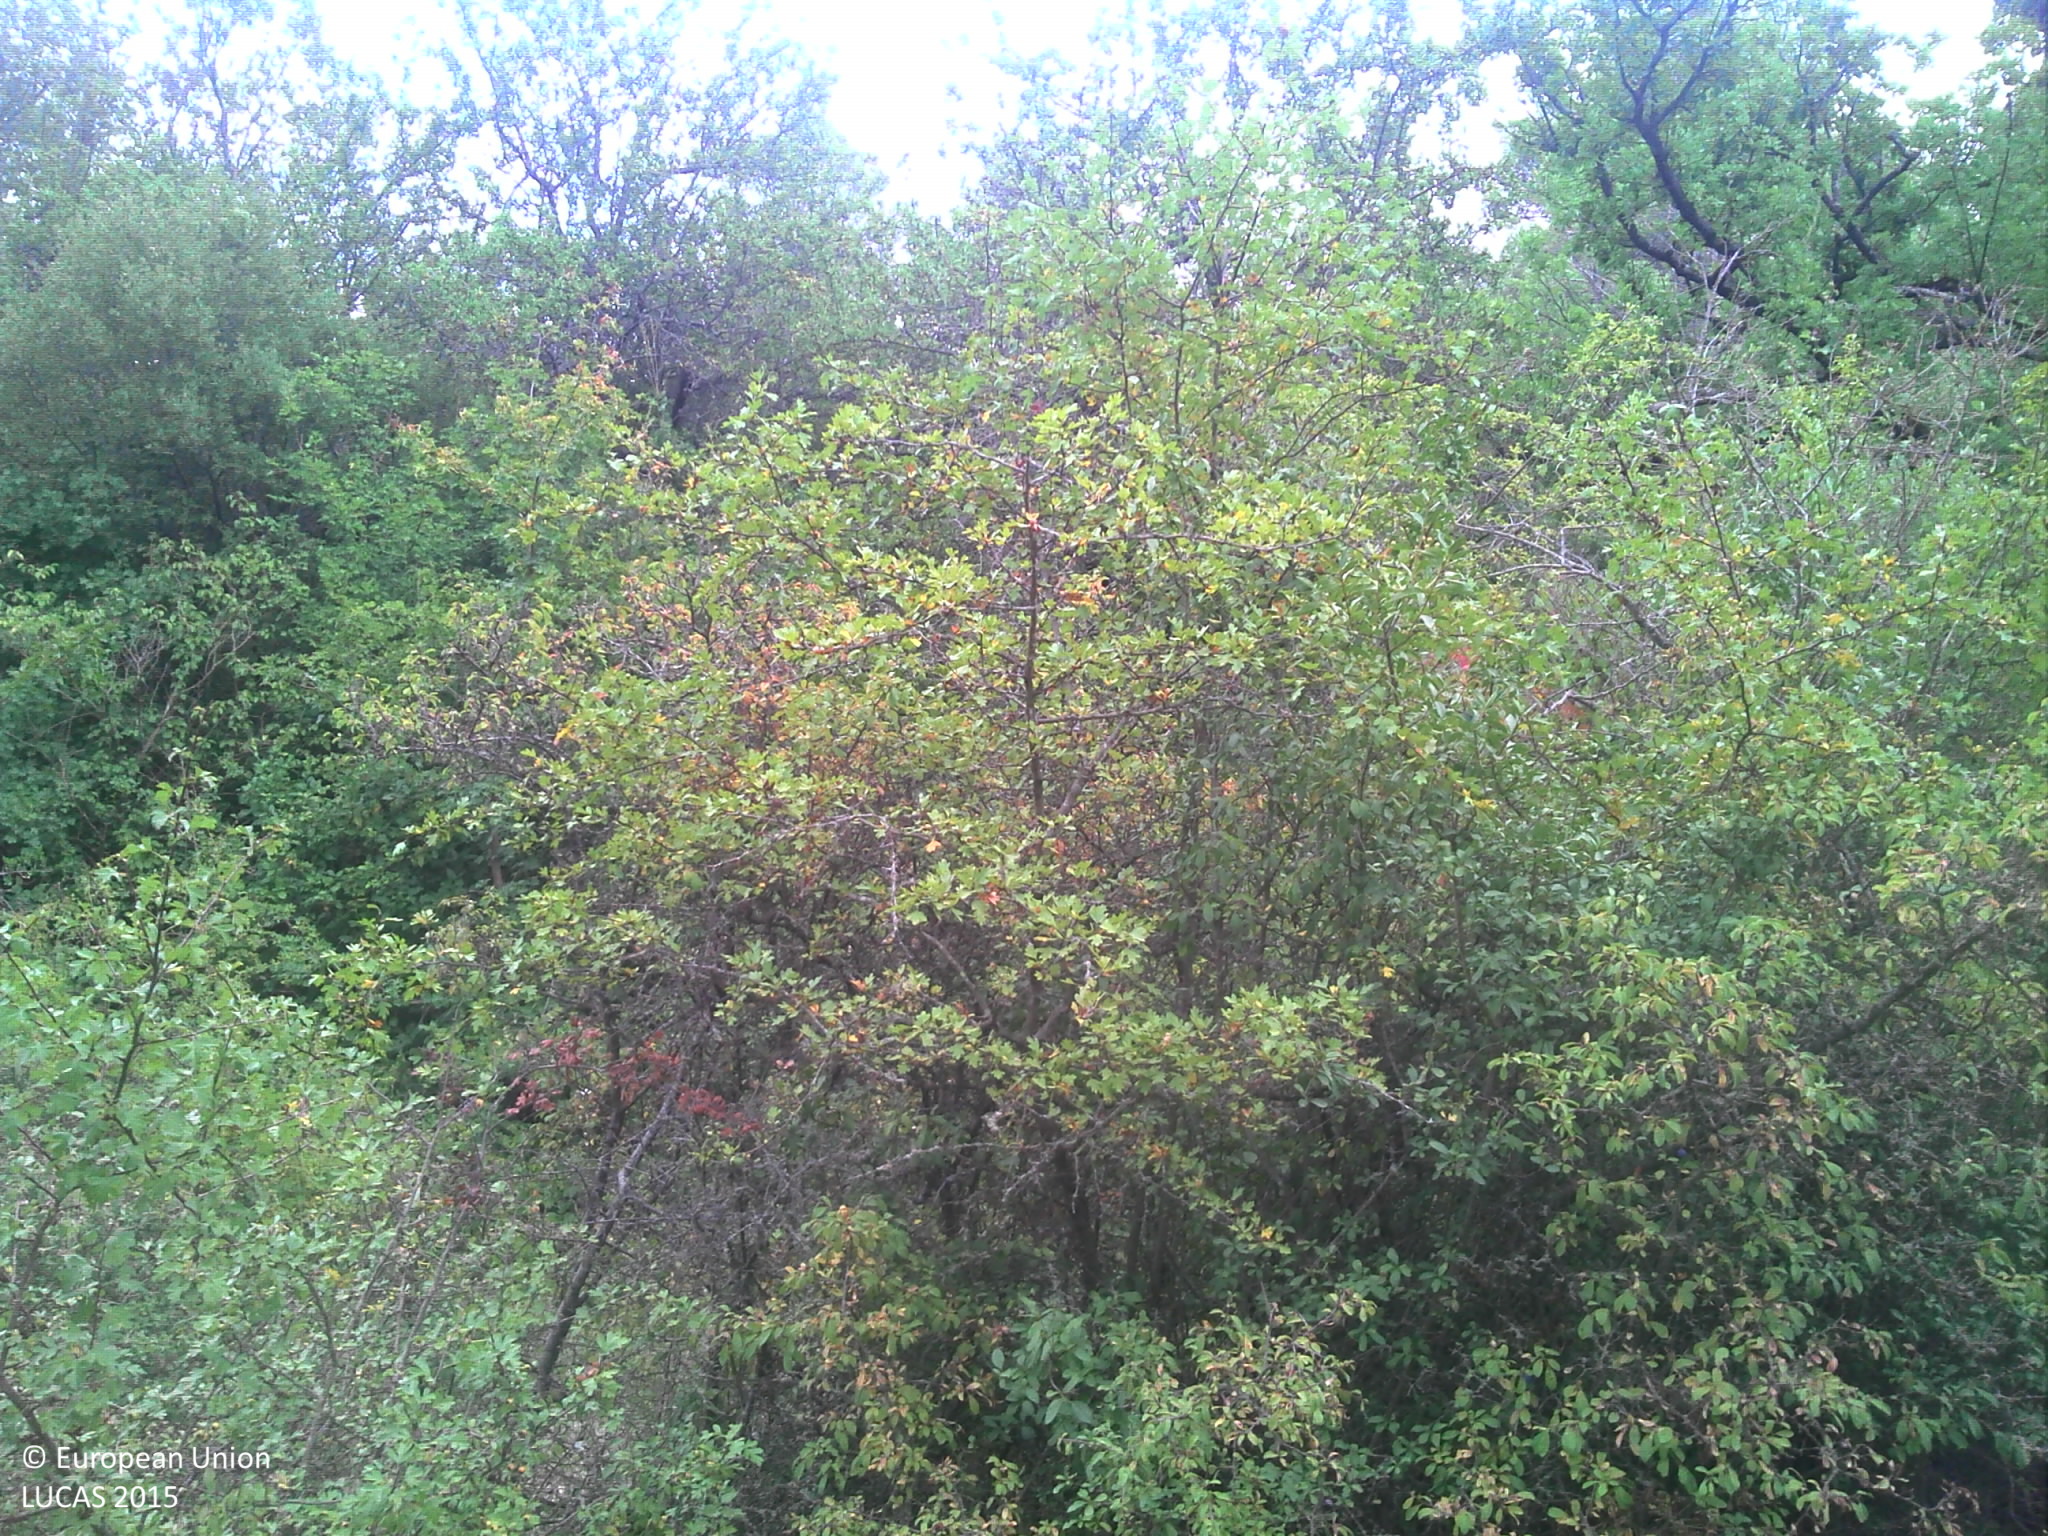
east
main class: Woodland
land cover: Pine dominated mixed woodland
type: coniferous forest of the mediterranean region
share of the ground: > 75 %
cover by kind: coniferous forest trees 45 %, broadleaved forest trees 30 %, shrubs 25 %
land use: Sport
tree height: < 5 m
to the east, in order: Pine dominated mixed woodland; Electric lines; Broadleaved woodland; Tracks; Broadleaved woodland; Tracks; Pine dominated mixed woodland; Tracks; Broadleaved woodland
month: August
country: FR
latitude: 43.4251
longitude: 5.5754
